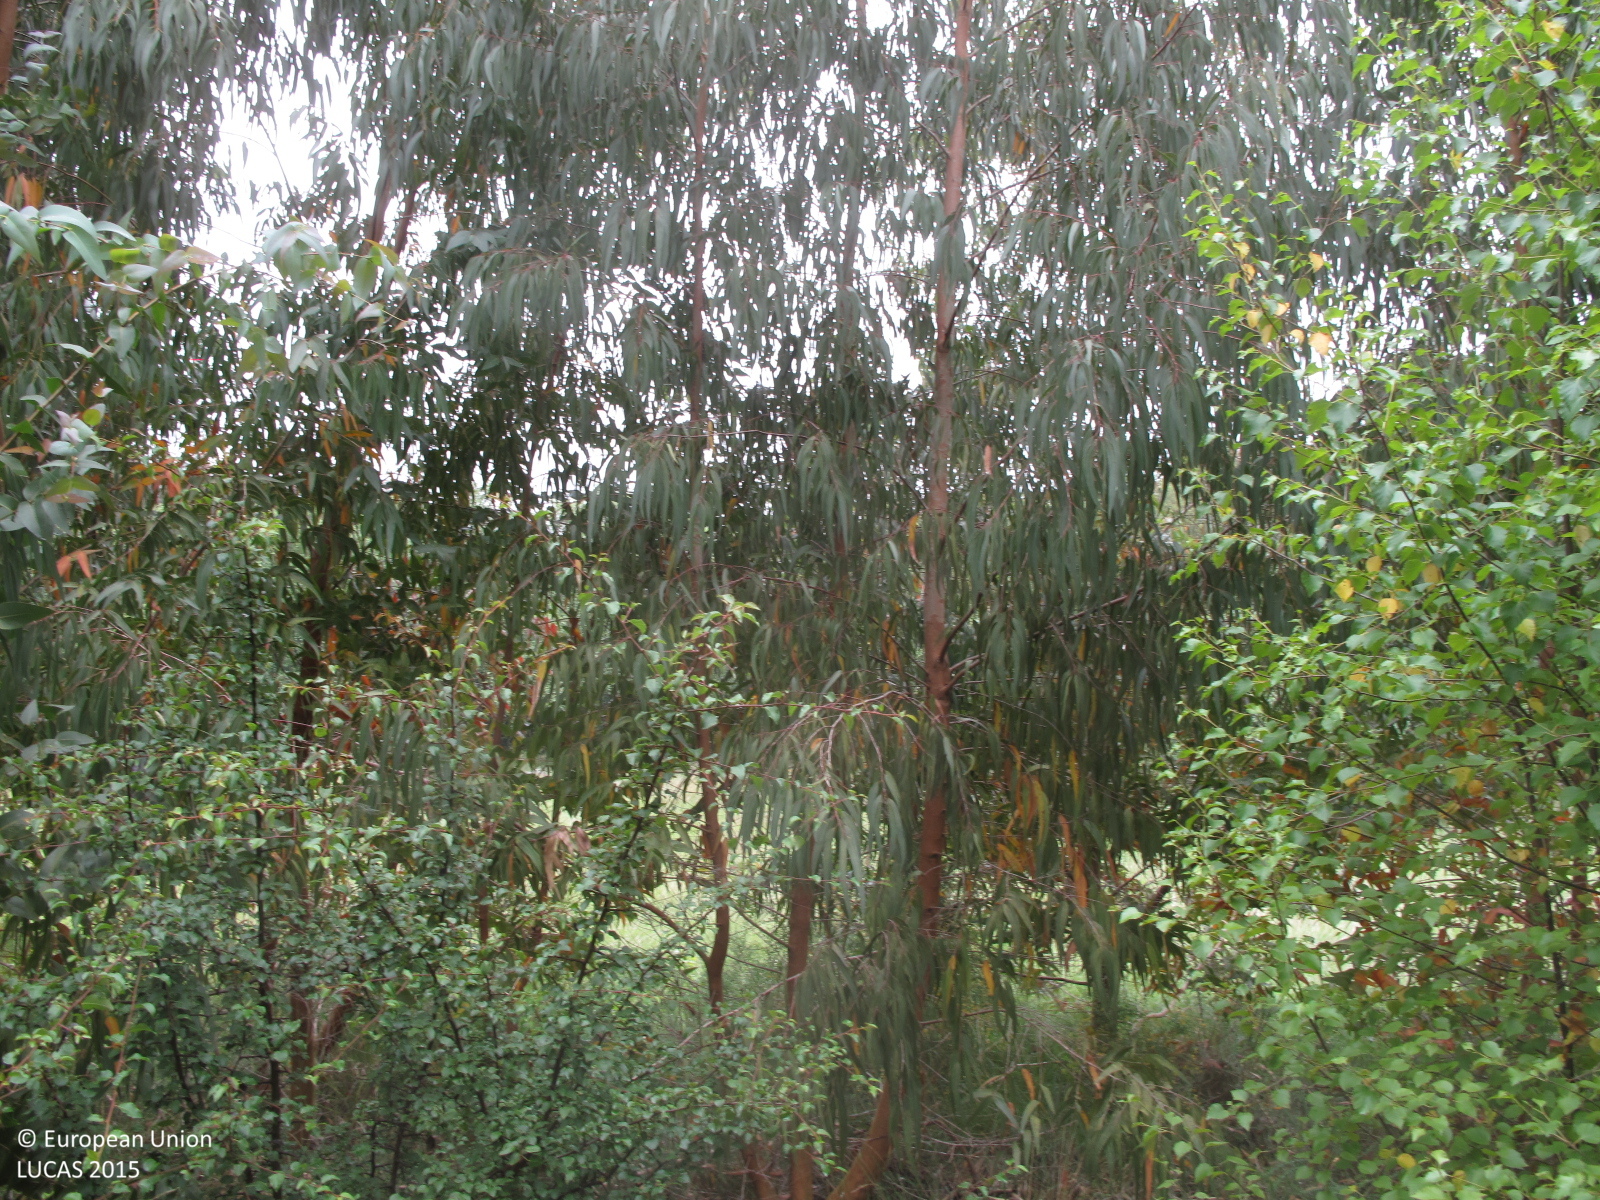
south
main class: Woodland
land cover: Broadleaved woodland
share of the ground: 50 - 75 %
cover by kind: broadleaved forest trees 70 %, shrubs 10 %, herbaceous plants 10 %, unconsolidated bare surface 10 %
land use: Forestry
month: June
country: ES
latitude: 43.1643
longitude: -8.1142
